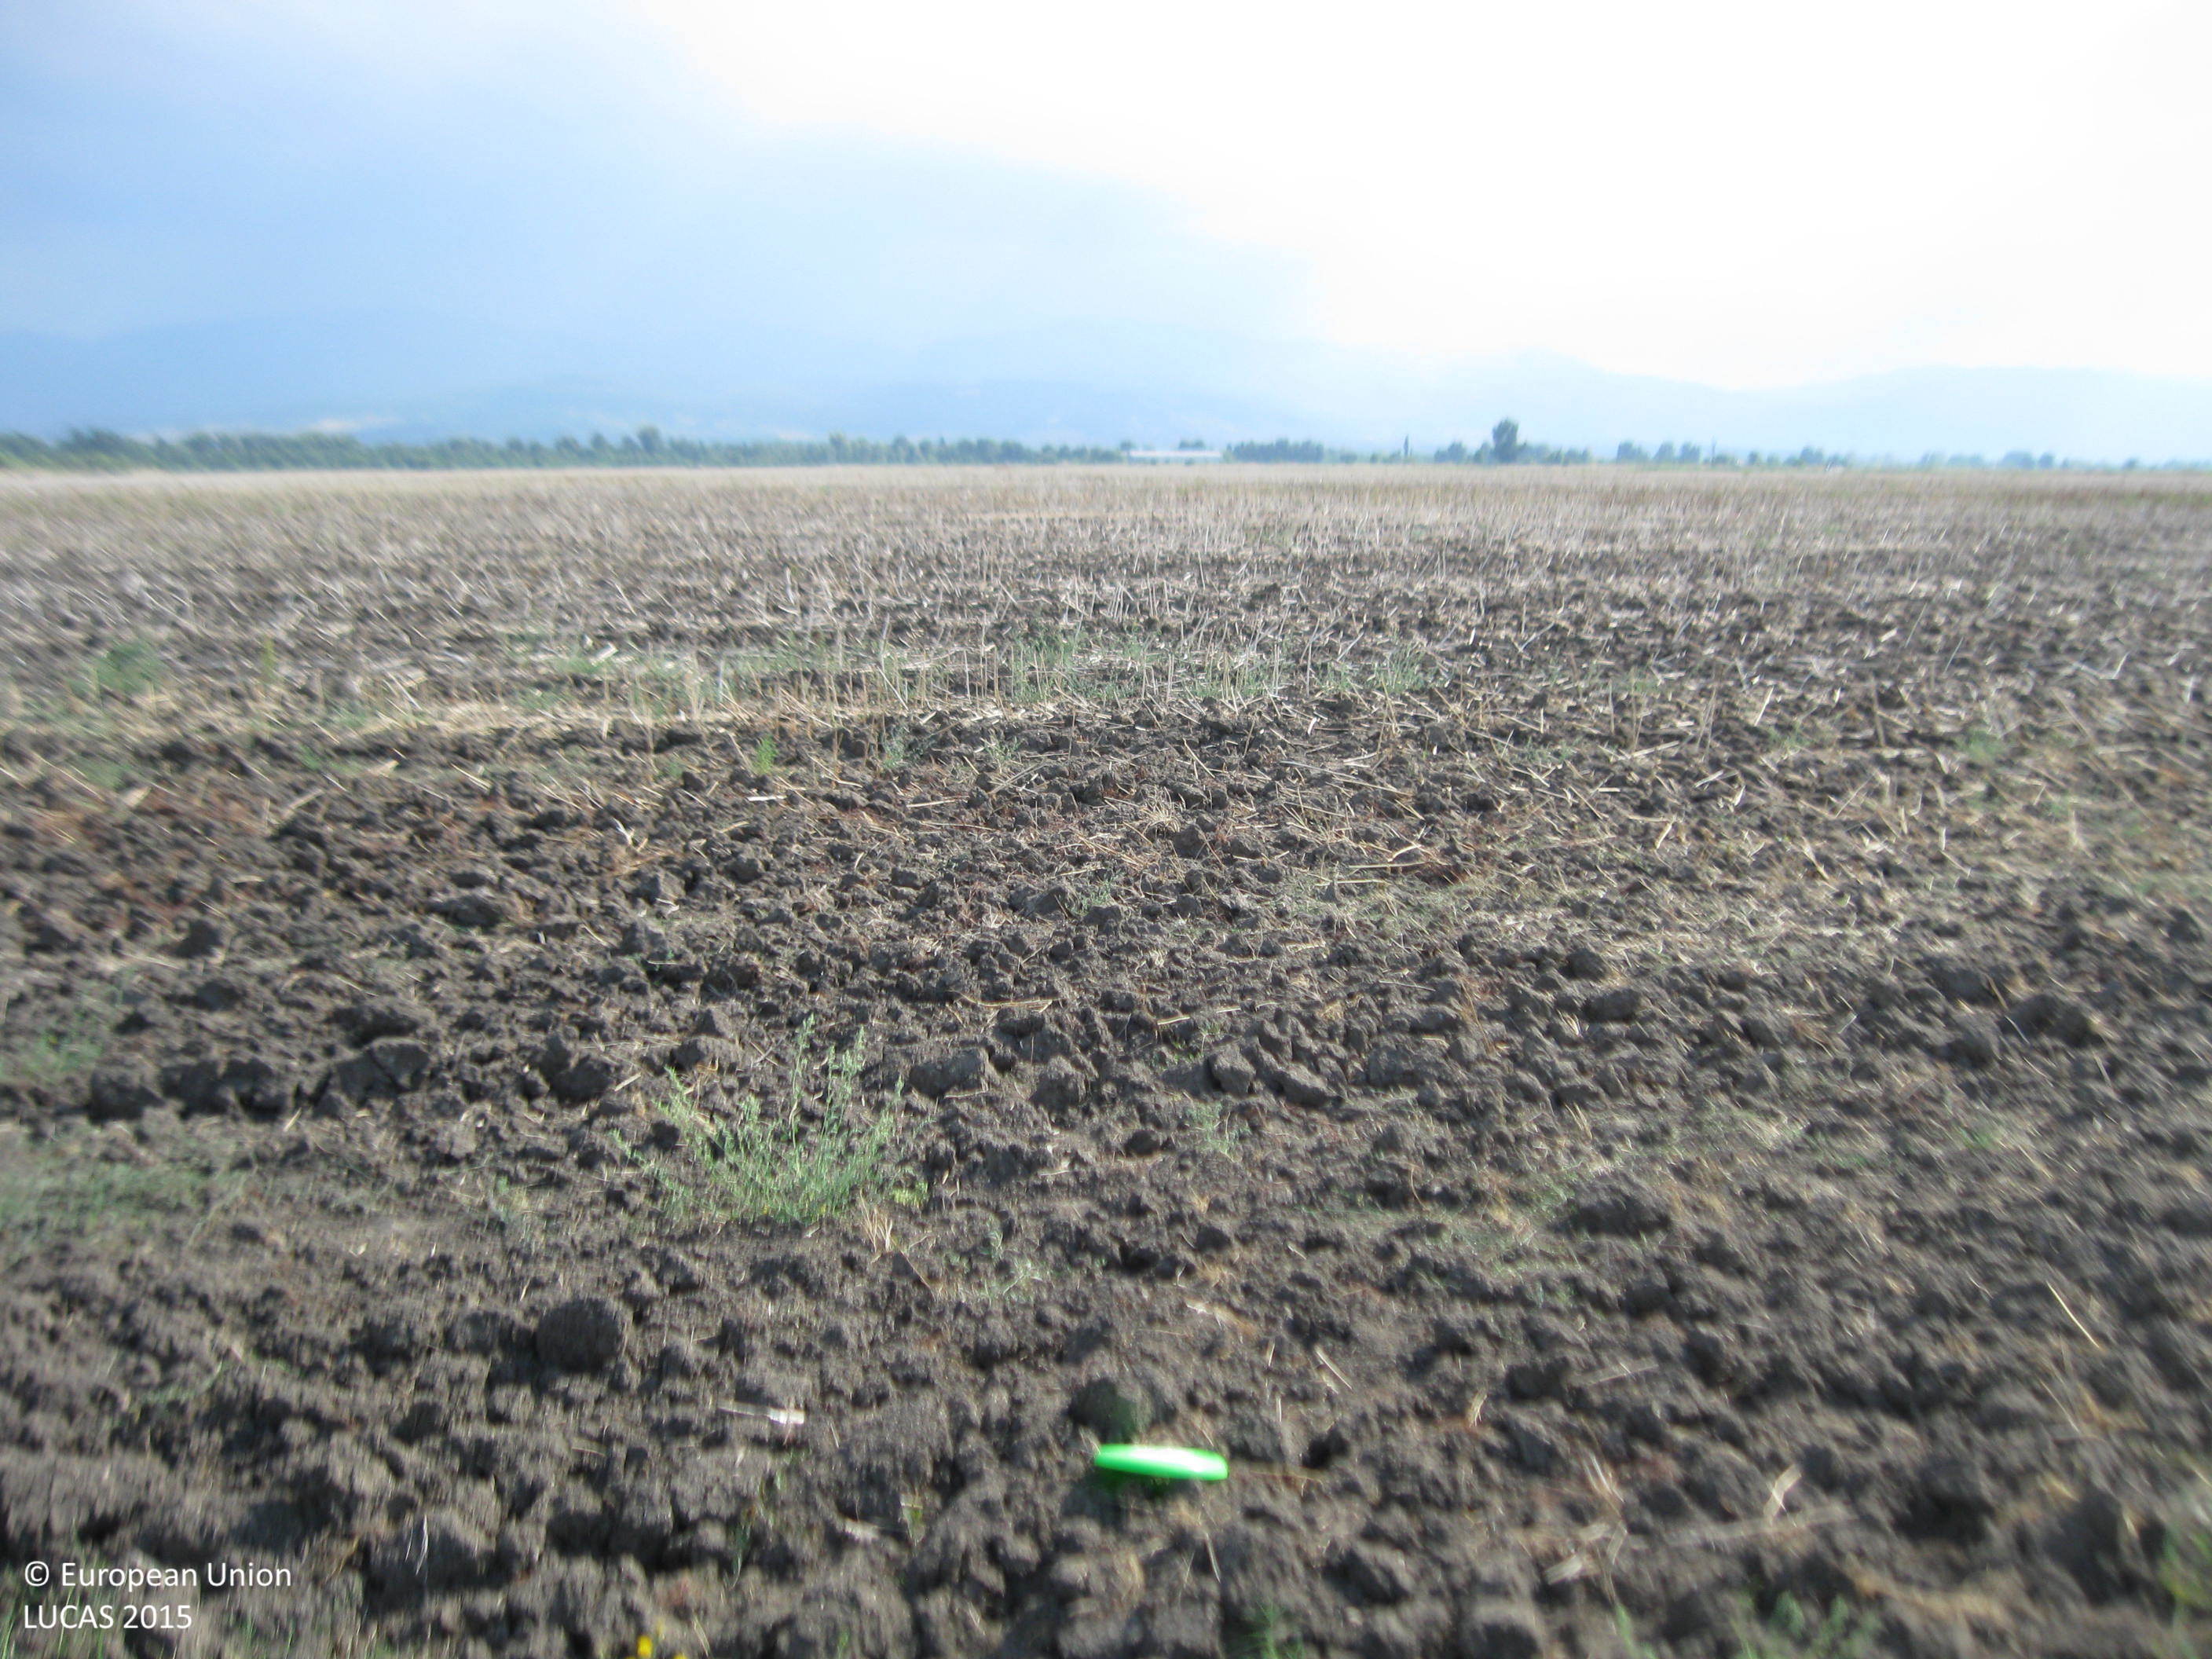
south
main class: Cropland
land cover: Rape and turnip rape
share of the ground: < 10 %
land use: Agriculture (excluding fallow land and kitchen gardens)
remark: Harvested field
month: August
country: BG
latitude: 42.1706
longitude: 24.6365
